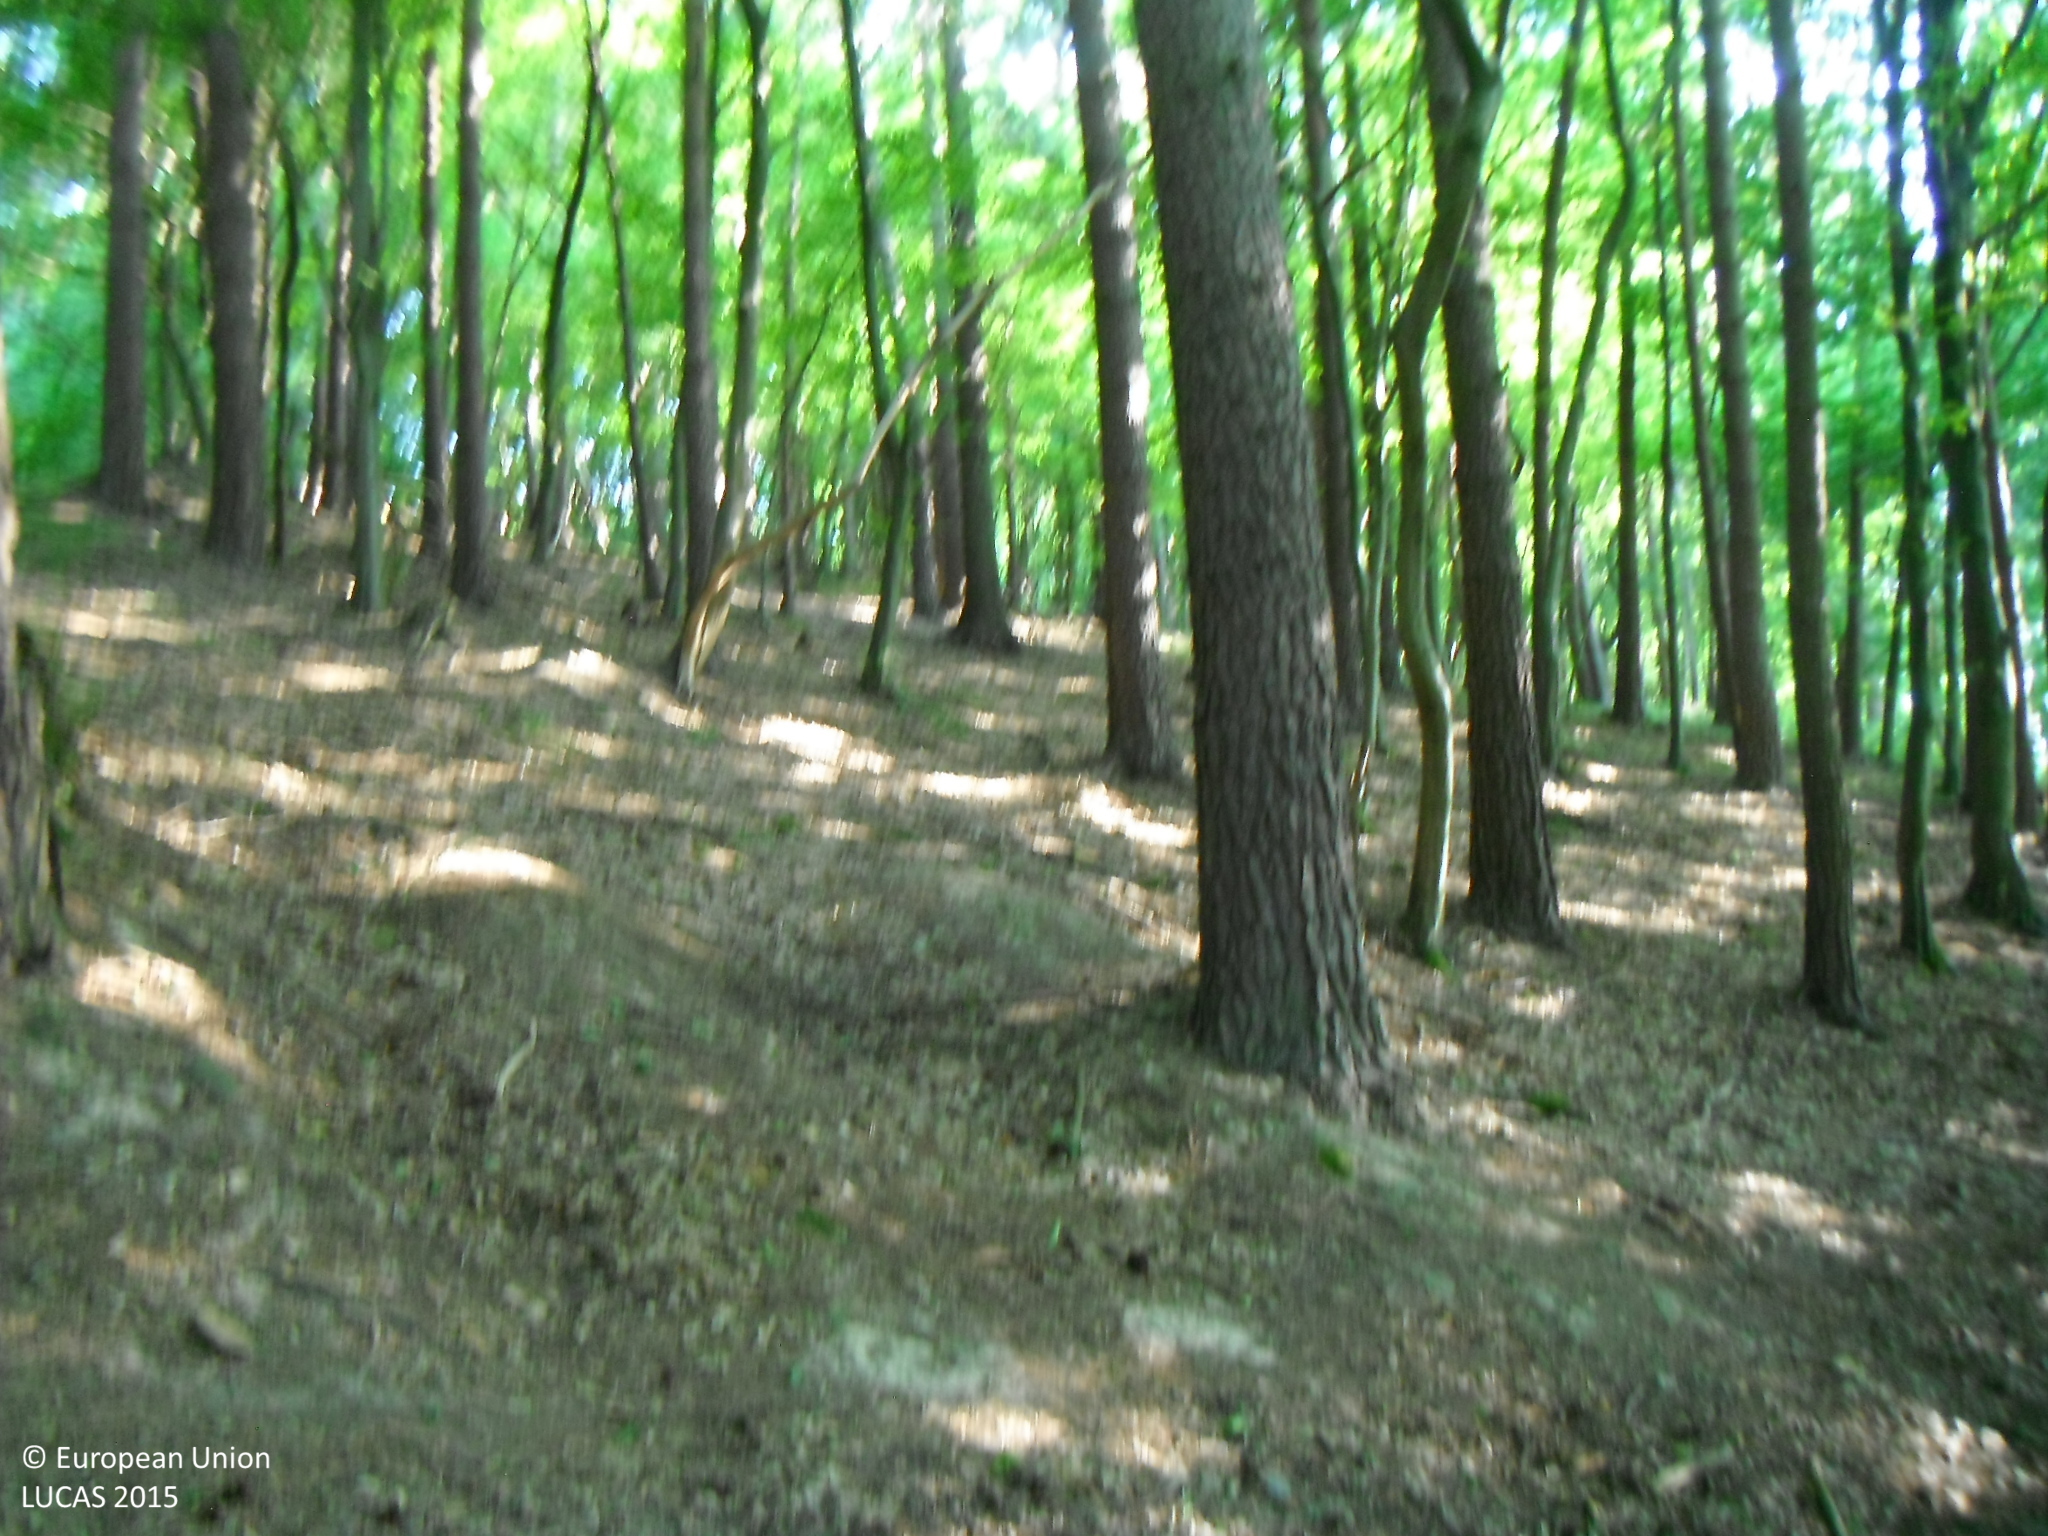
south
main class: Woodland
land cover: Pine dominated mixed woodland
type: hemiboreal forest and nemoral coniferous forest and mixed broadleaved-coniferous forest
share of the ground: > 75 %
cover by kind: coniferous forest trees 50 %, broadleaved forest trees 50 %
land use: Forestry
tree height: > 5 m
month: July
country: SK
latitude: 49.1091
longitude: 18.4699
